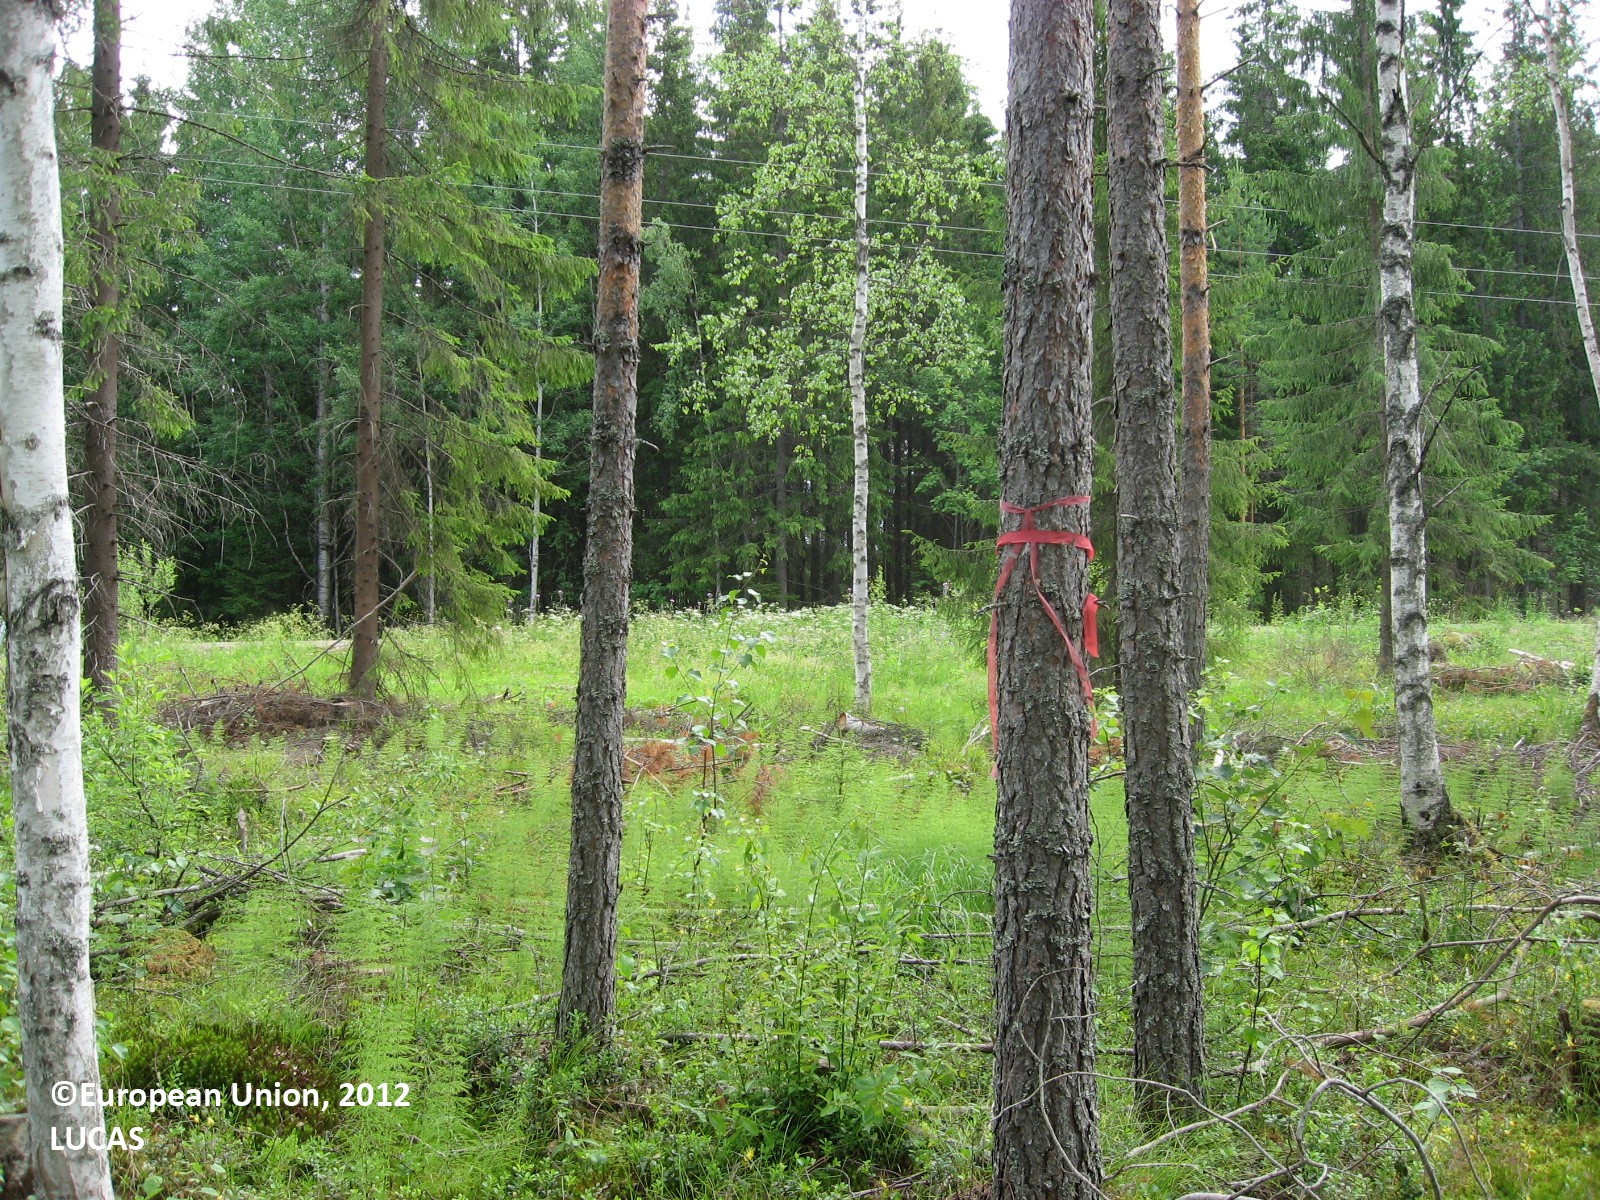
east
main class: Woodland
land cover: Other mixed woodland
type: mire and swamp forests
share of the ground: 25 - 50 %
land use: Forestry
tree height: > 5 m
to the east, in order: Other mixed woodland; Spruce dominated mixed woodland; Ditches and canals; Spruce dominated mixed woodland; Spontaneously vegetated surfaces; Electric lines; Paved roads, cycling and walking lanes; Spontaneously vegetated surfaces; Spruce dominated mixed woodland; Spruce dominated coniferous woodland; Spruce dominated mixed woodland; Ditches and canals; Other leguminous and mixtures for fodder; Electric lines; Other leguminous and mixtures for fodder; Ditches and canals; Broadleaved woodland; Other leguminous and mixtures for fodder; Electric lines; Other leguminous and mixtures for fodder
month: July
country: FI
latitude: 60.8927
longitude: 26.5370
